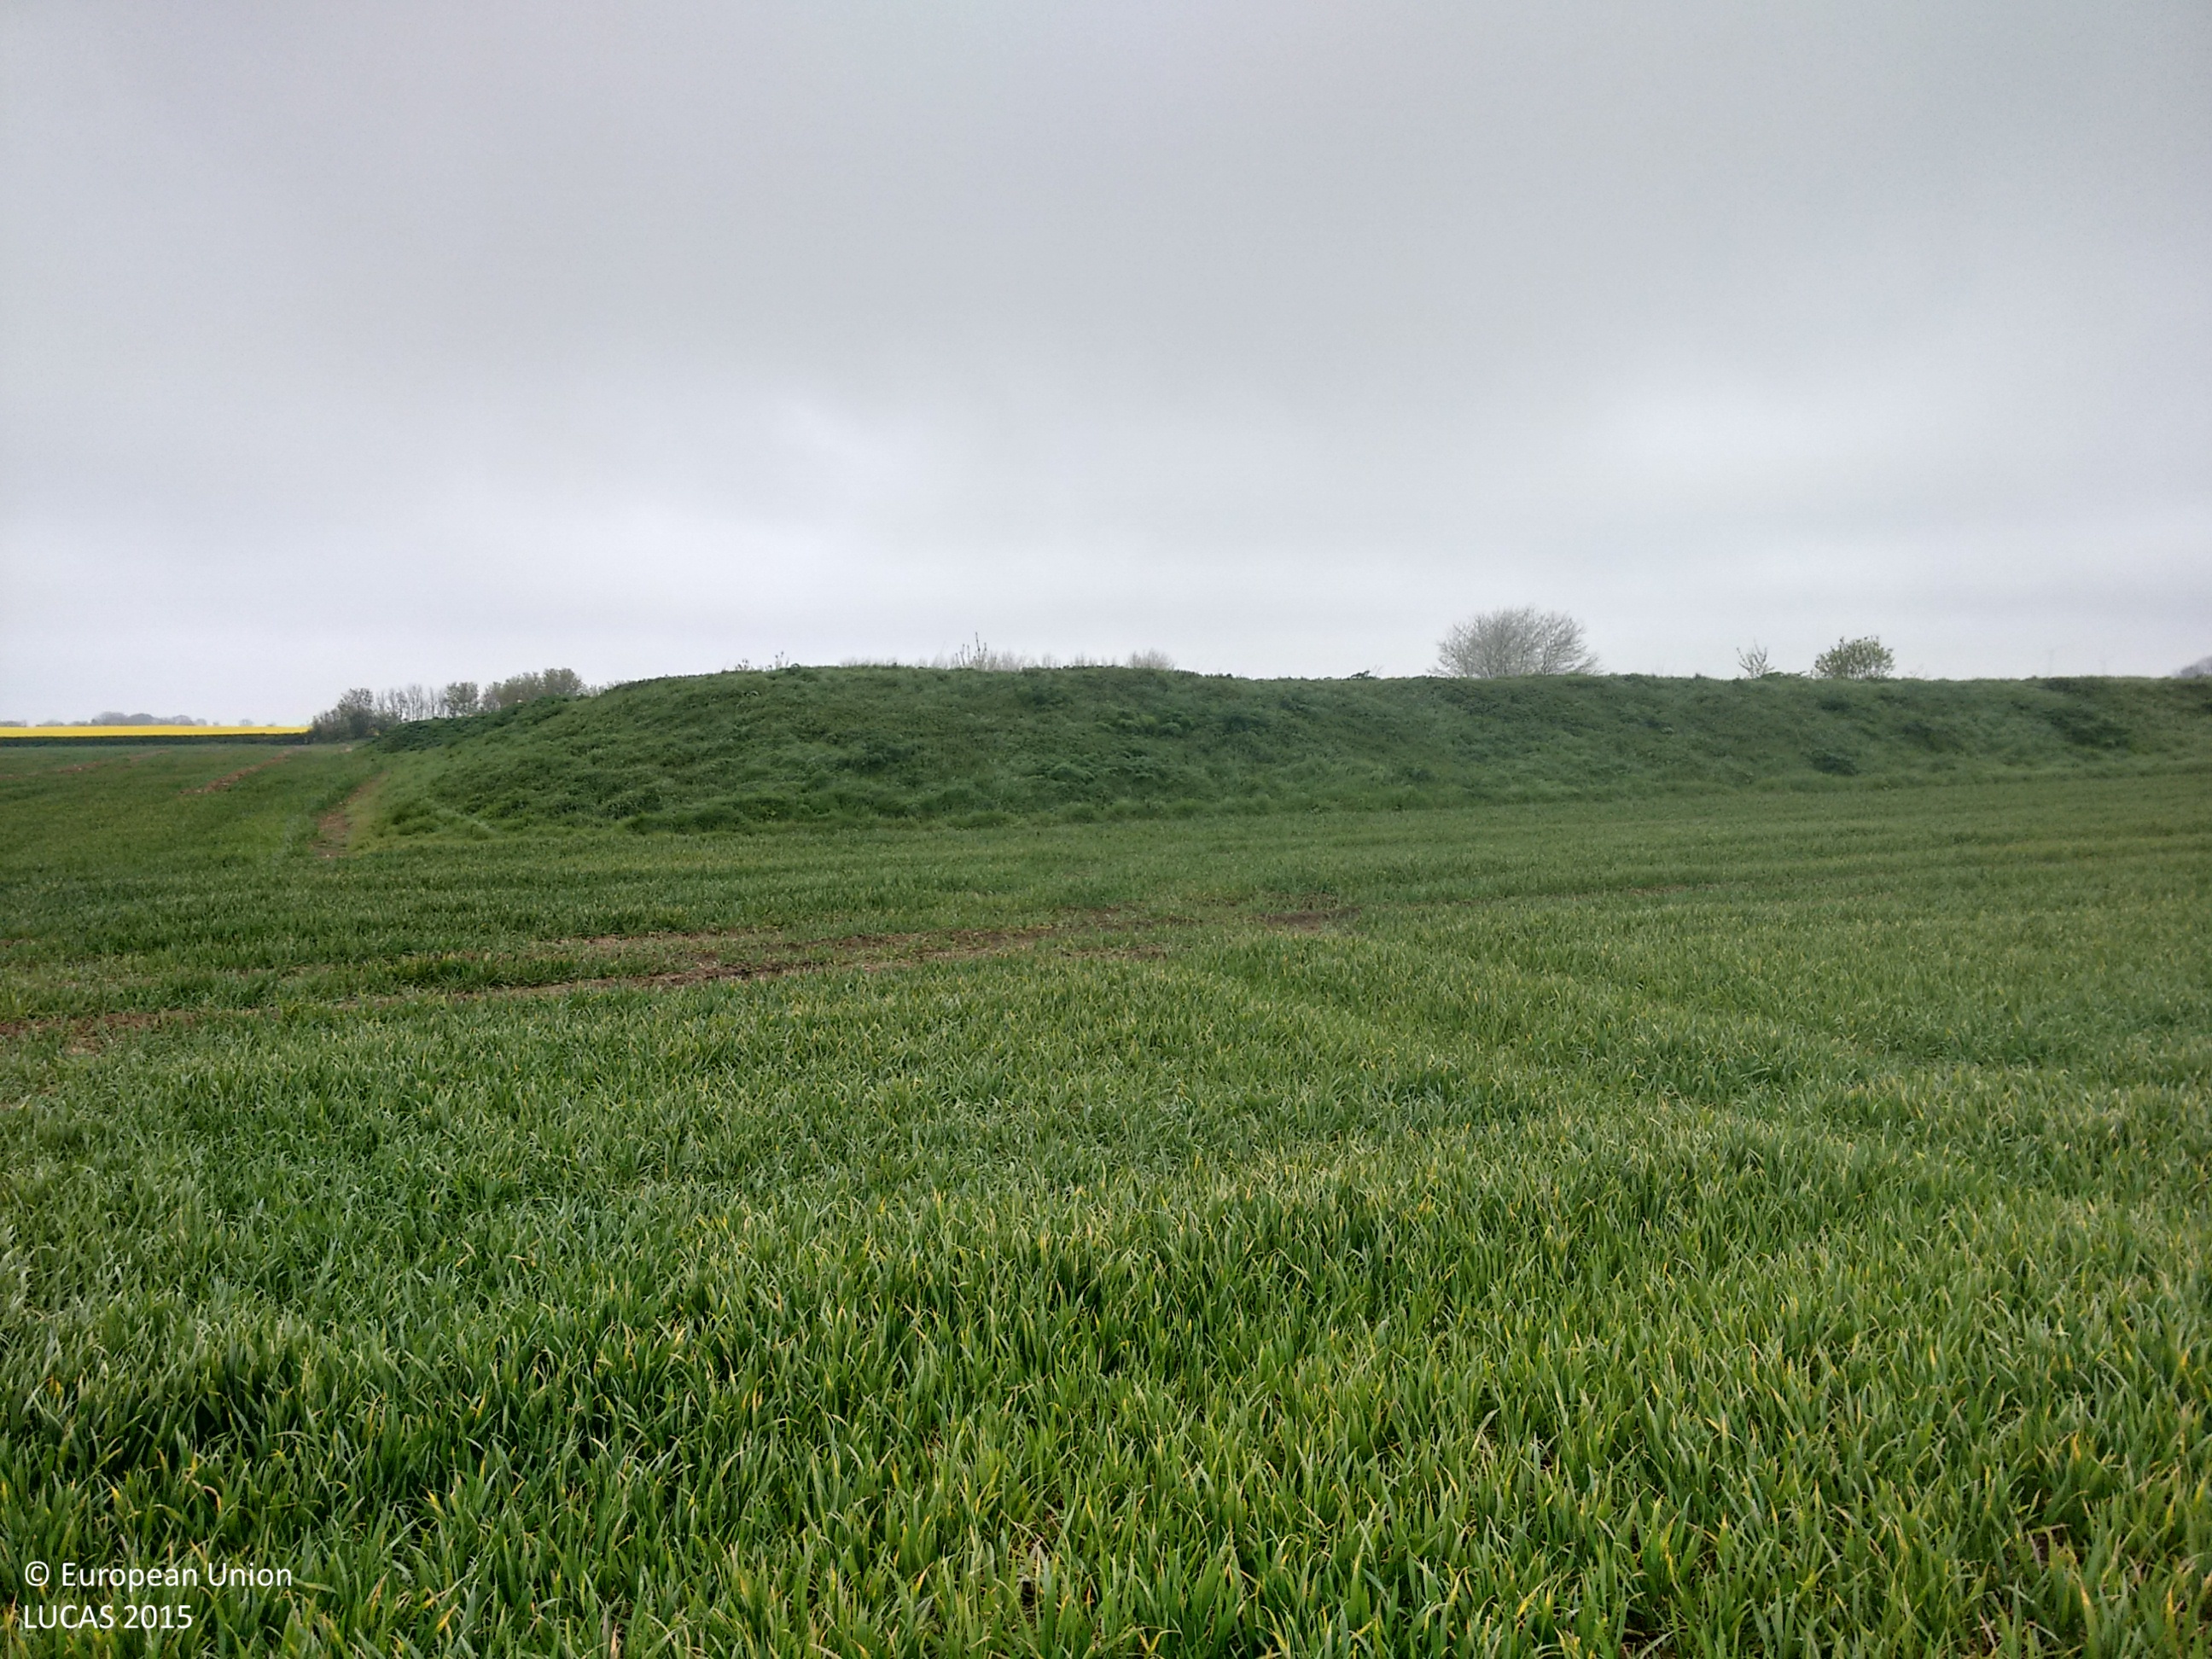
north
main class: Cropland
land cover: Common wheat
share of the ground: > 75 %
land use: Agriculture (excluding fallow land and kitchen gardens)
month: May
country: GB
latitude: 53.9772
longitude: -0.2957
